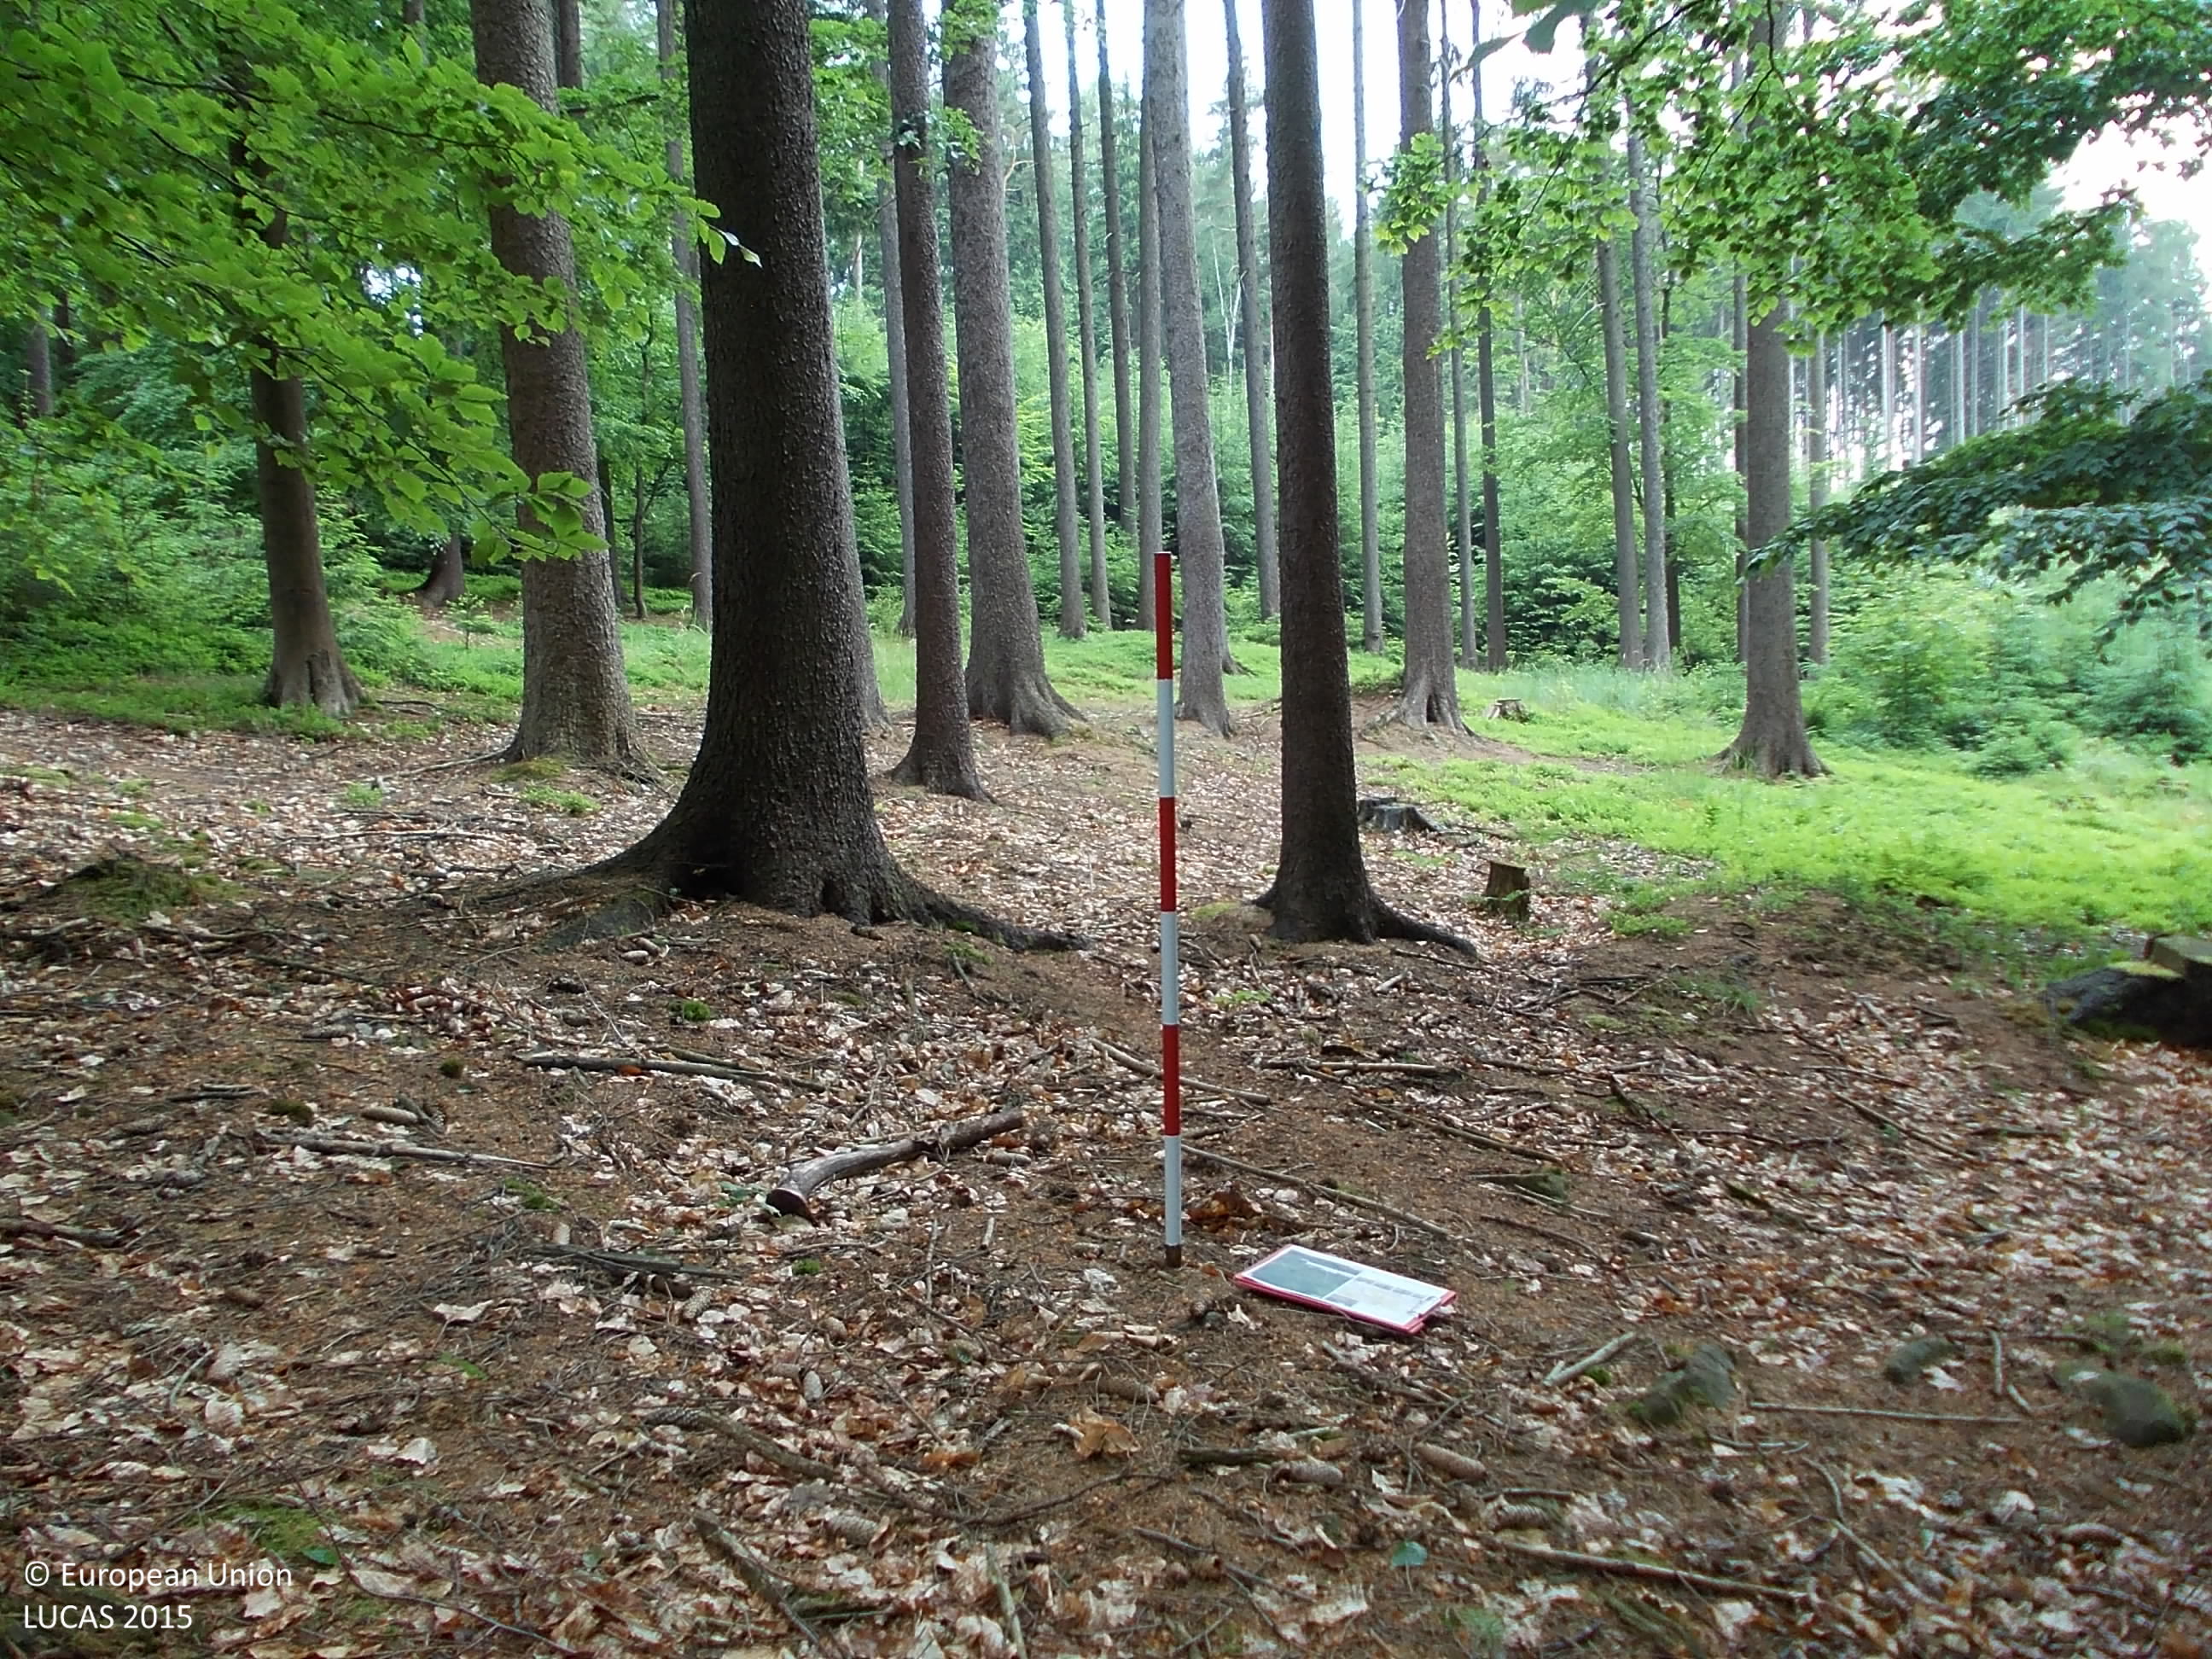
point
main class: Woodland
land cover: Spruce dominated mixed woodland
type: hemiboreal forest and nemoral coniferous forest and mixed broadleaved-coniferous forest
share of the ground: > 75 %
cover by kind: coniferous forest trees 65 %, broadleaved forest trees 30 %, herbaceous plants 5 %
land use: Forestry
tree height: > 5 m
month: June
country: CZ
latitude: 50.0637
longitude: 16.3071
